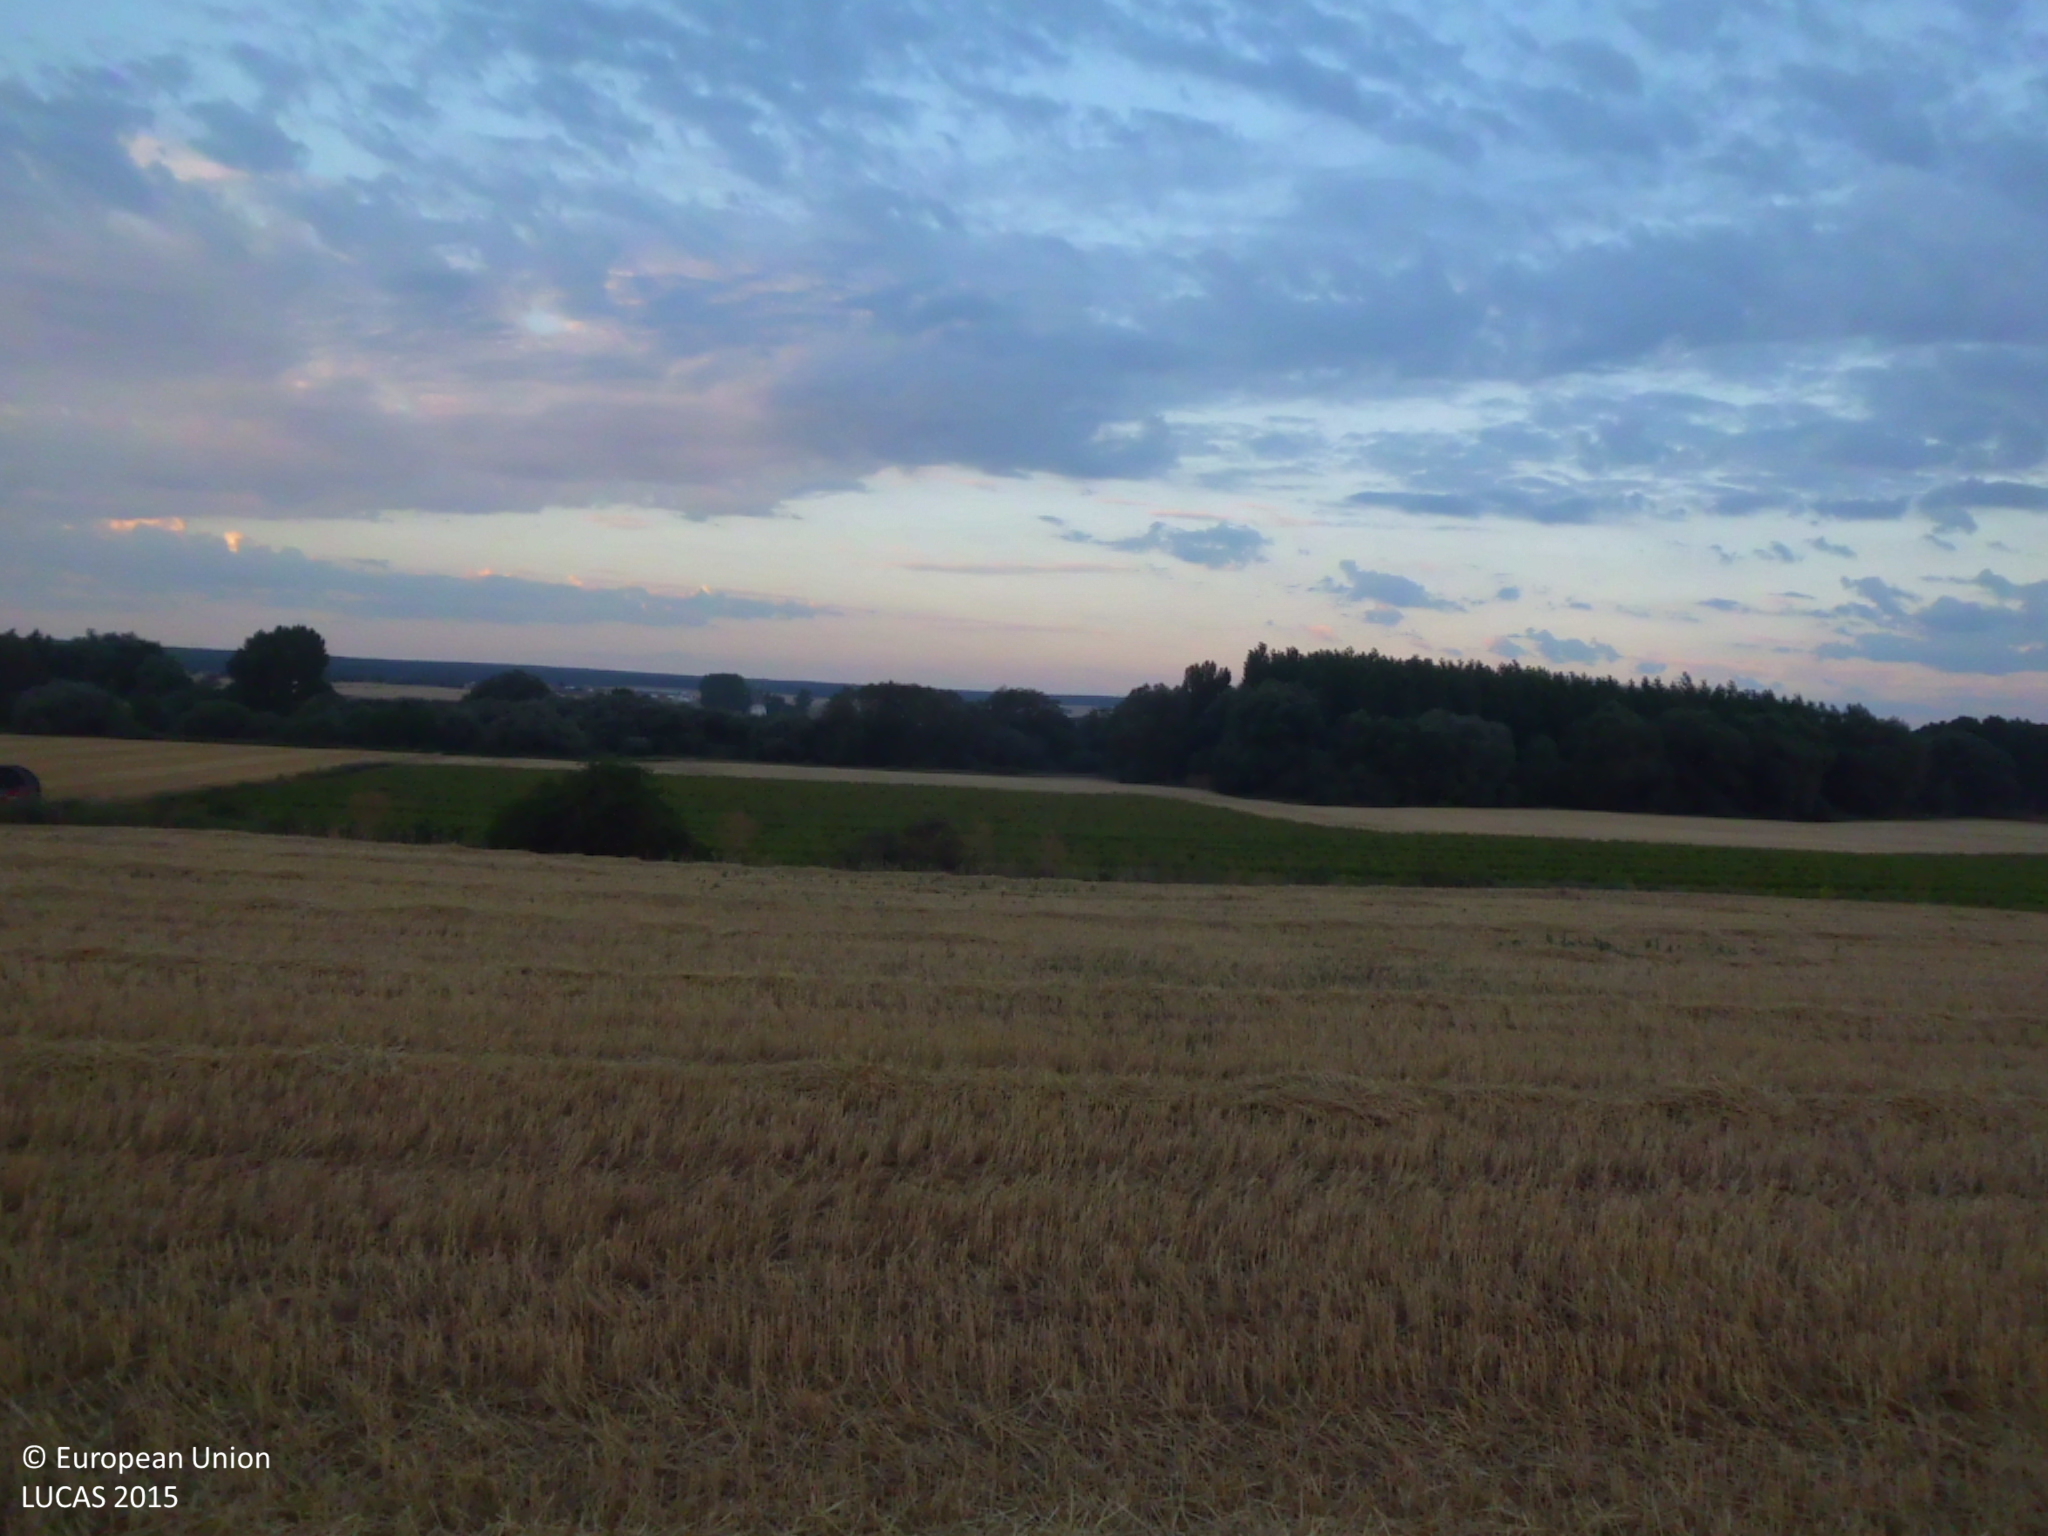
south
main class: Cropland
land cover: Barley
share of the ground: < 10 %
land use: Agriculture (excluding fallow land and kitchen gardens)
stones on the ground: < 10 %
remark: Harvested field
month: July
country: ES
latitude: 42.5905
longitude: -4.3932
